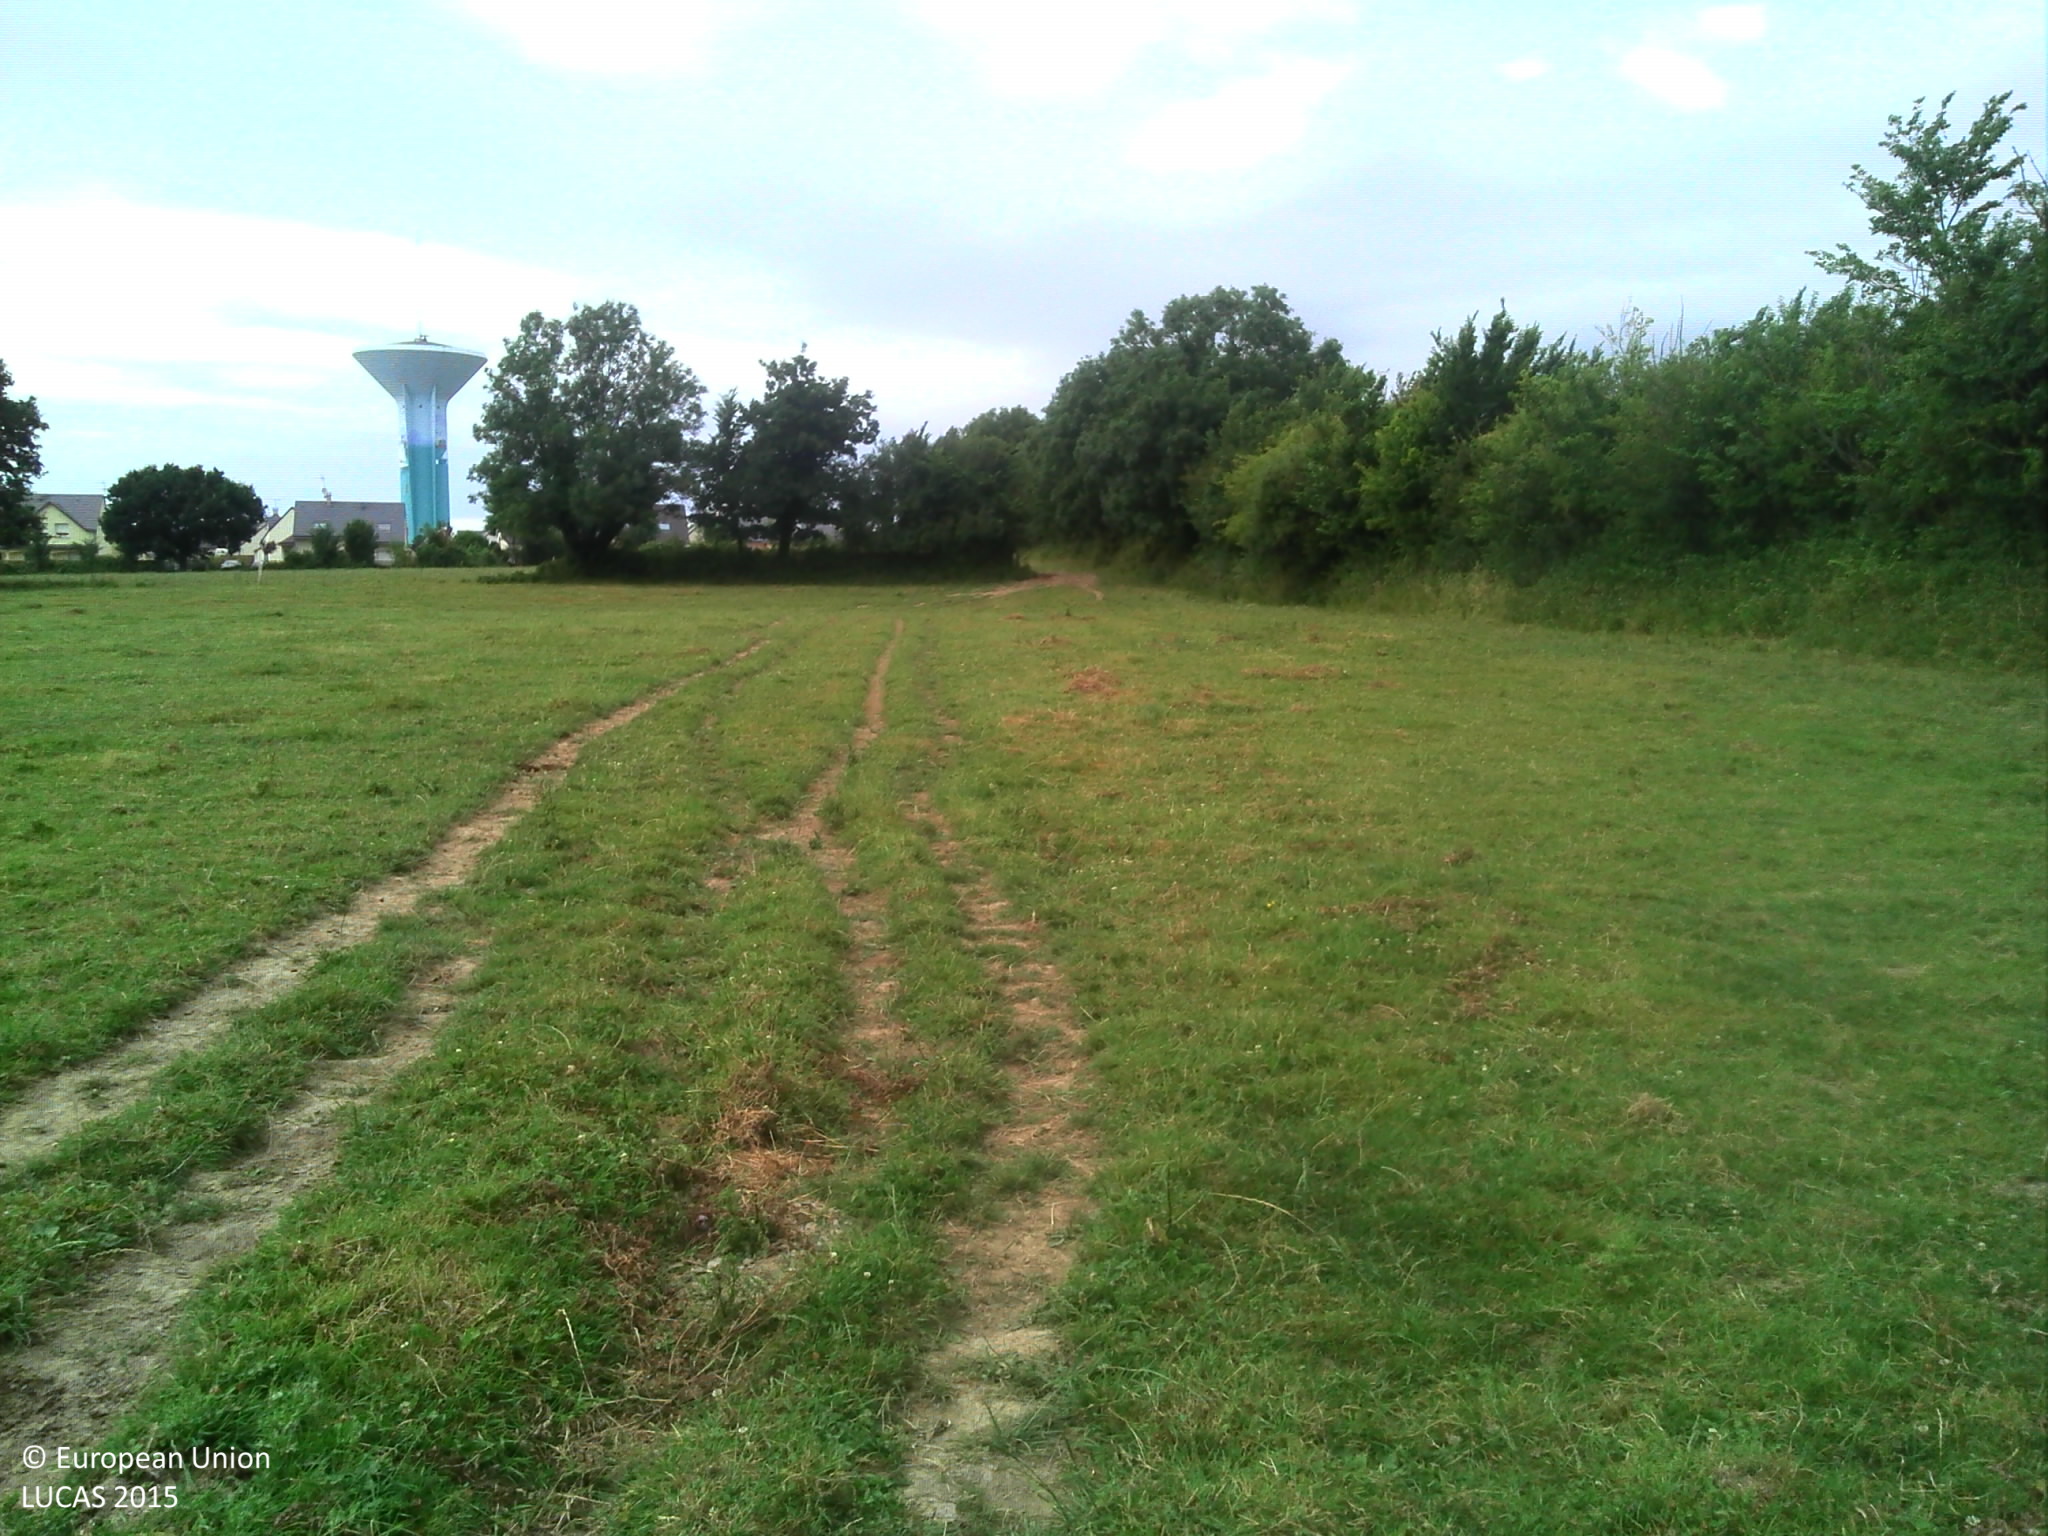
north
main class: Grassland
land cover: Grassland without tree/shrub cover
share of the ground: > 75 %
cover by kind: herbaceous plants 100 %
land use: Agriculture (excluding fallow land and kitchen gardens)
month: July
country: FR
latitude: 48.8308
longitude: -1.5600
